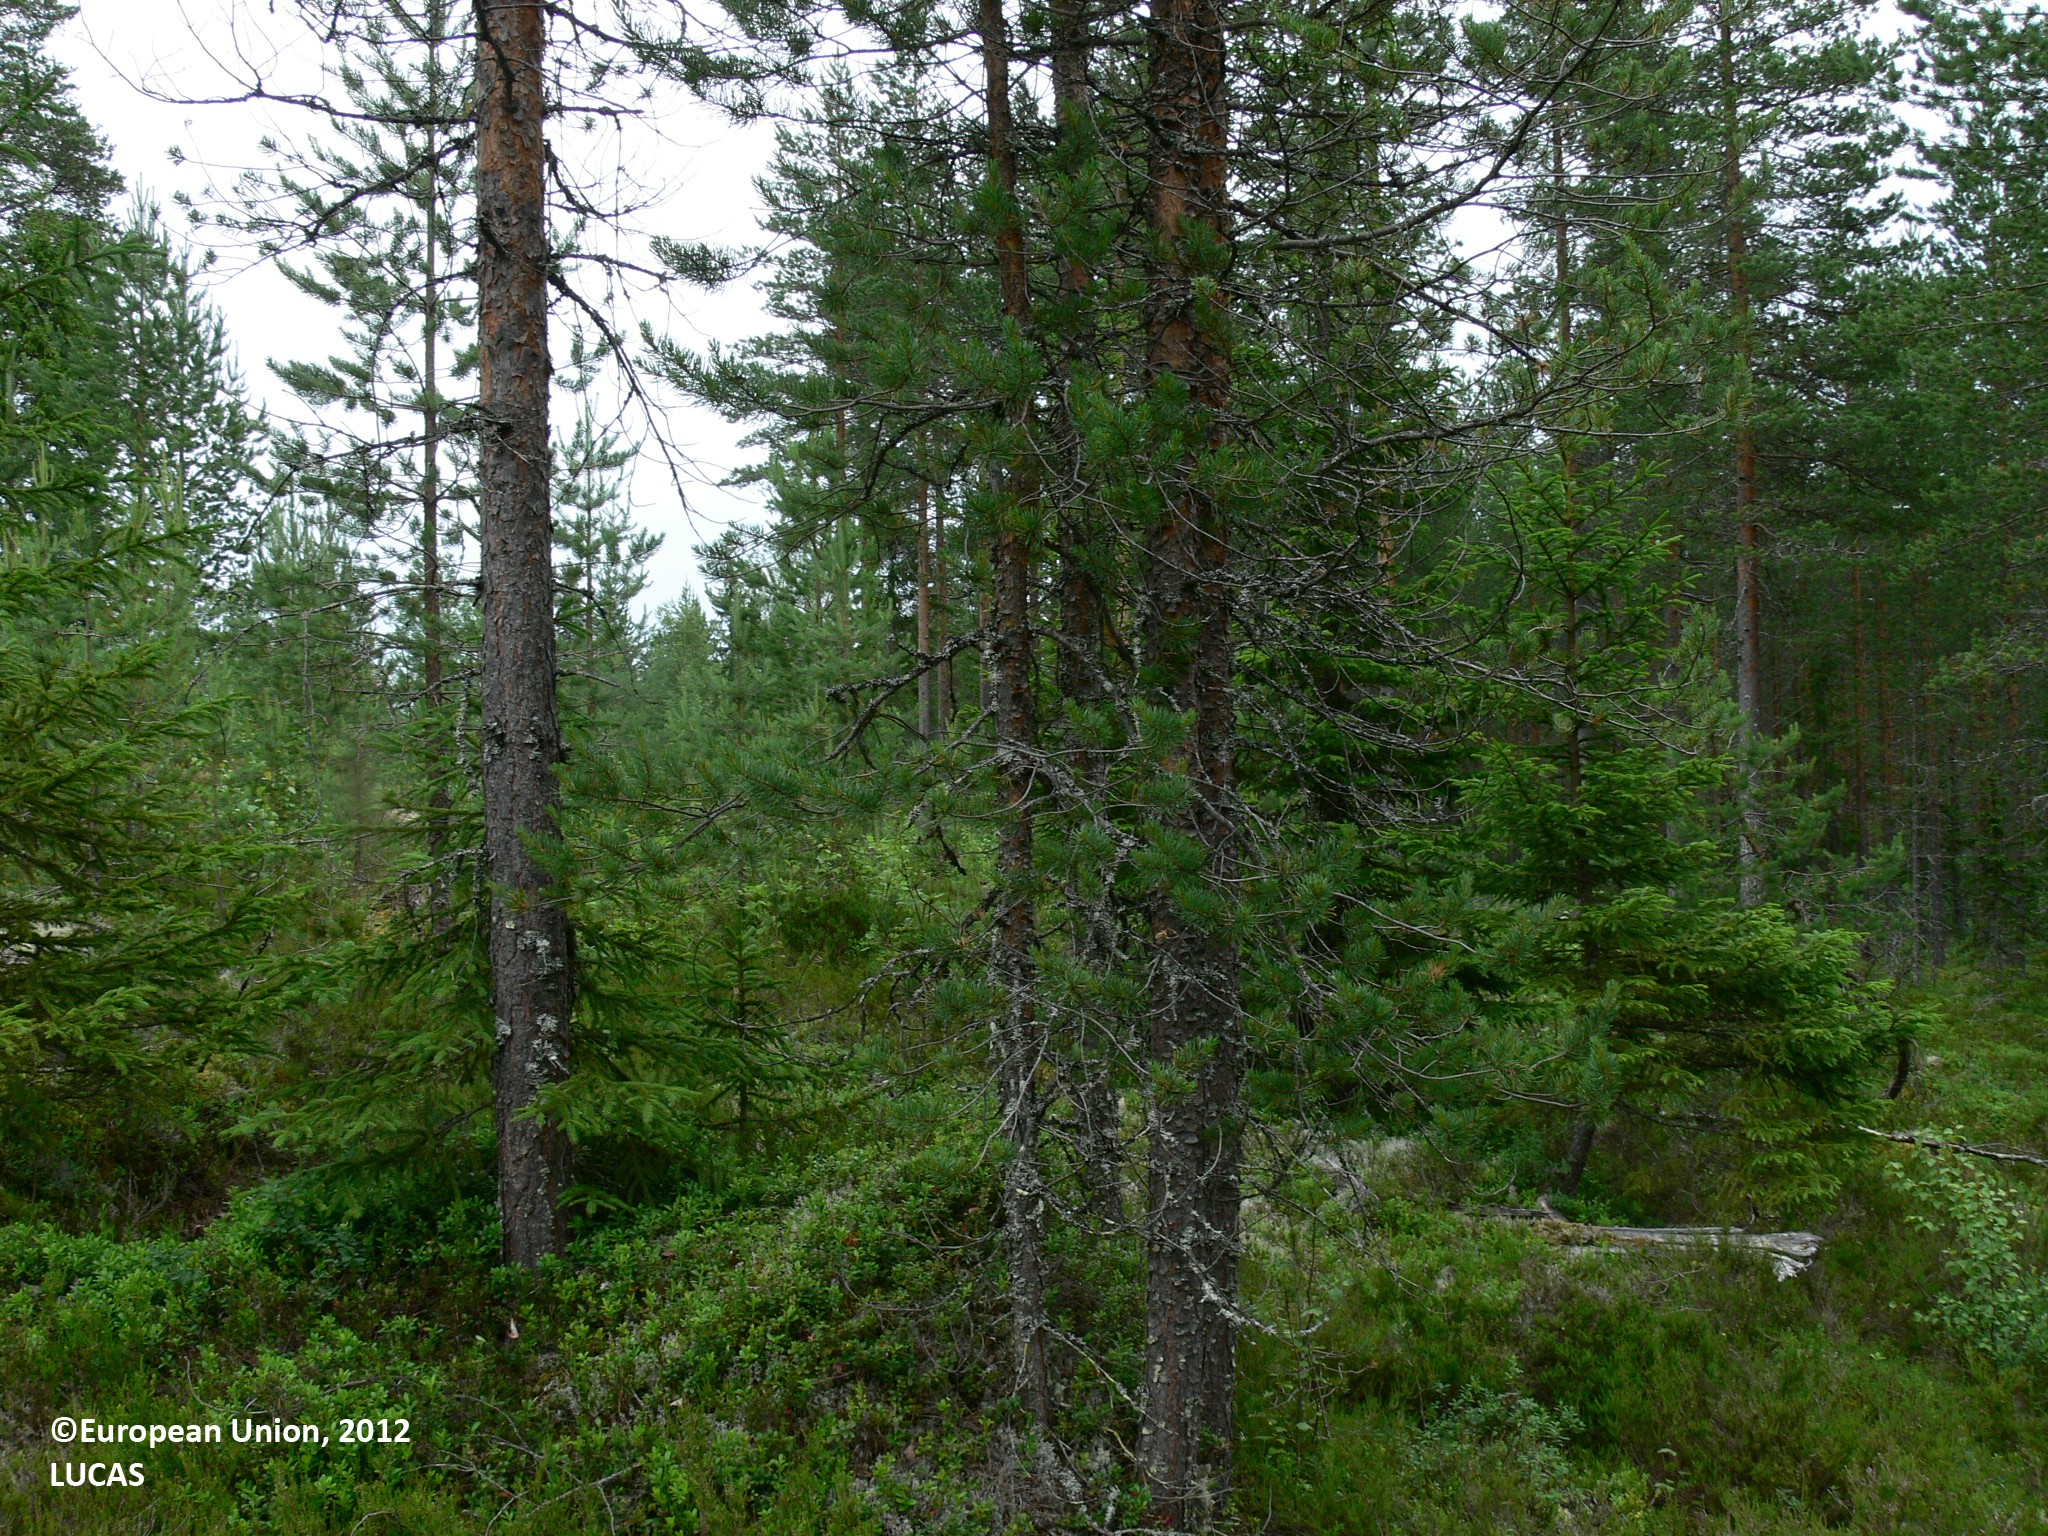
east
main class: Woodland
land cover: Pine dominated coniferous woodland
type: boreal forest
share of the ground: 25 - 50 %
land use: Forestry
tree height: < 5 m
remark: Clear cut
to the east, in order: Pine dominated coniferous woodland; Other mixed woodland; Other coniferous woodland; Pine dominated coniferous woodland
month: July
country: FI
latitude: 63.2578
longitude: 30.7830
